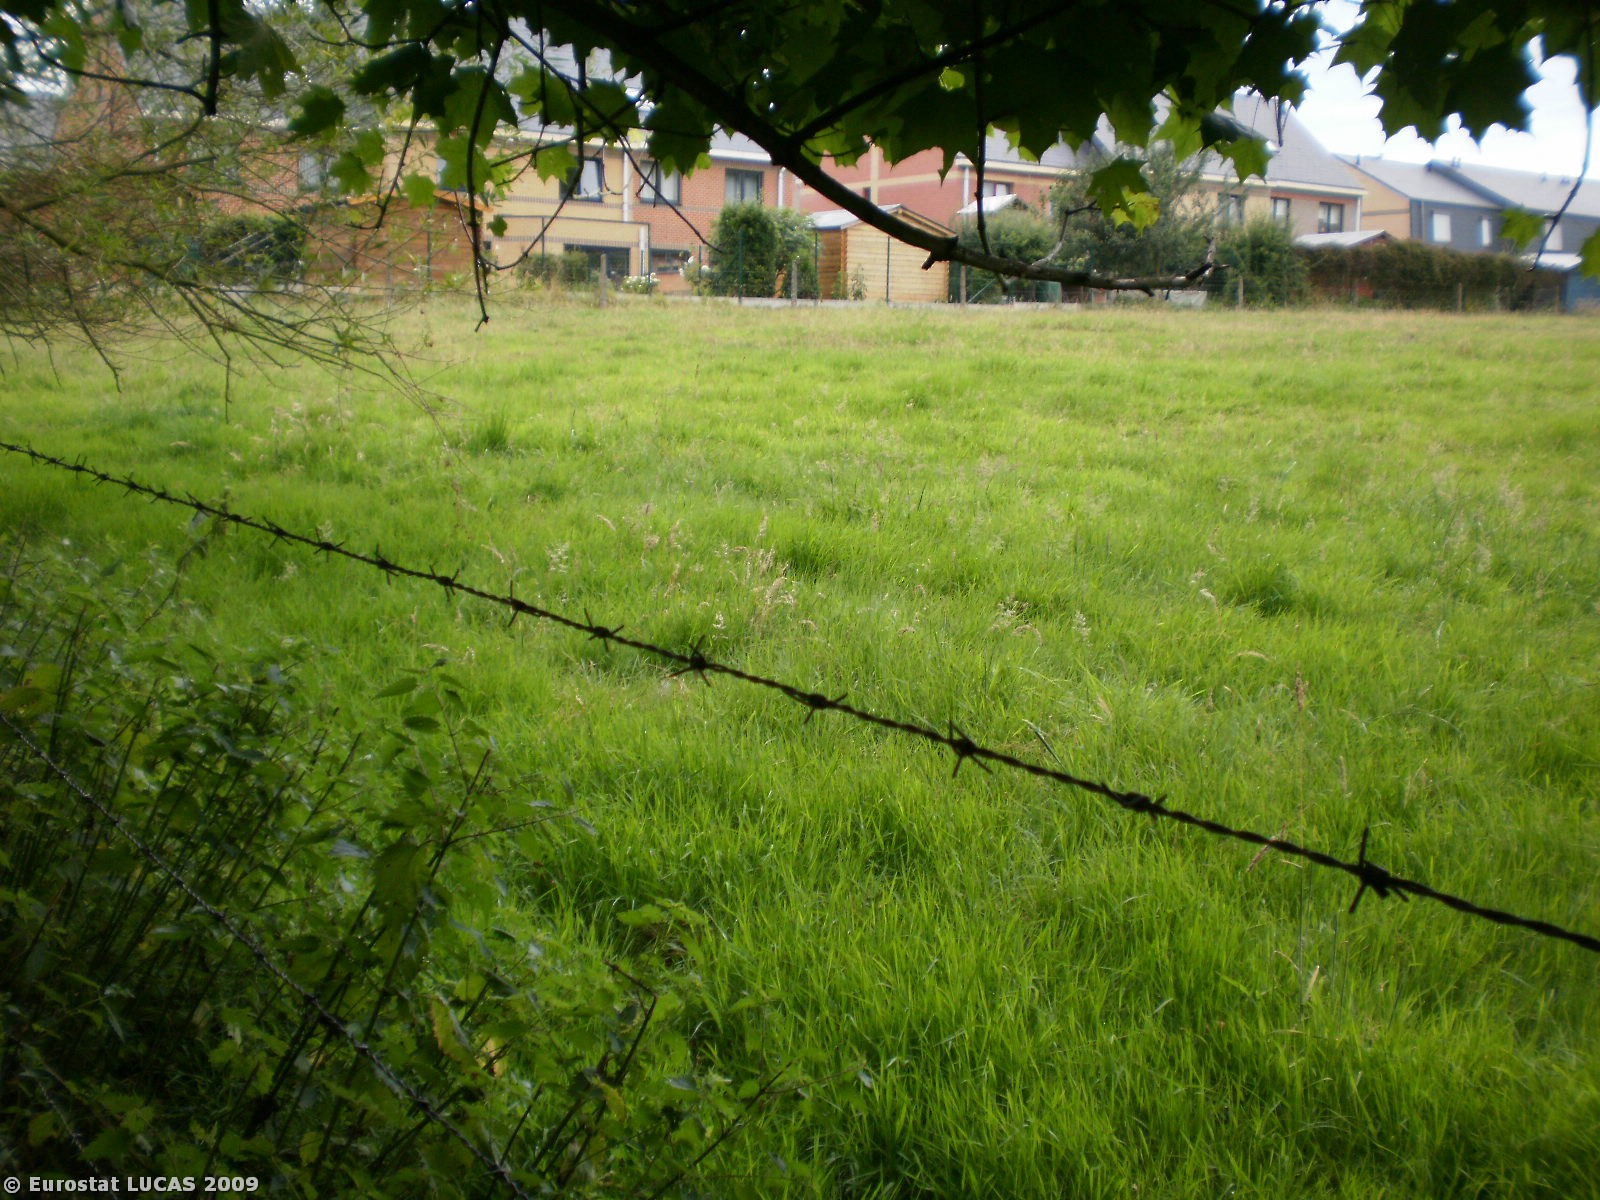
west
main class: Grassland
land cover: Grassland without tree/shrub cover
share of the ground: > 75 %
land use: Agriculture (excluding fallow land and kitchen gardens)
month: July
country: BE
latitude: 50.8693
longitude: 4.2685
